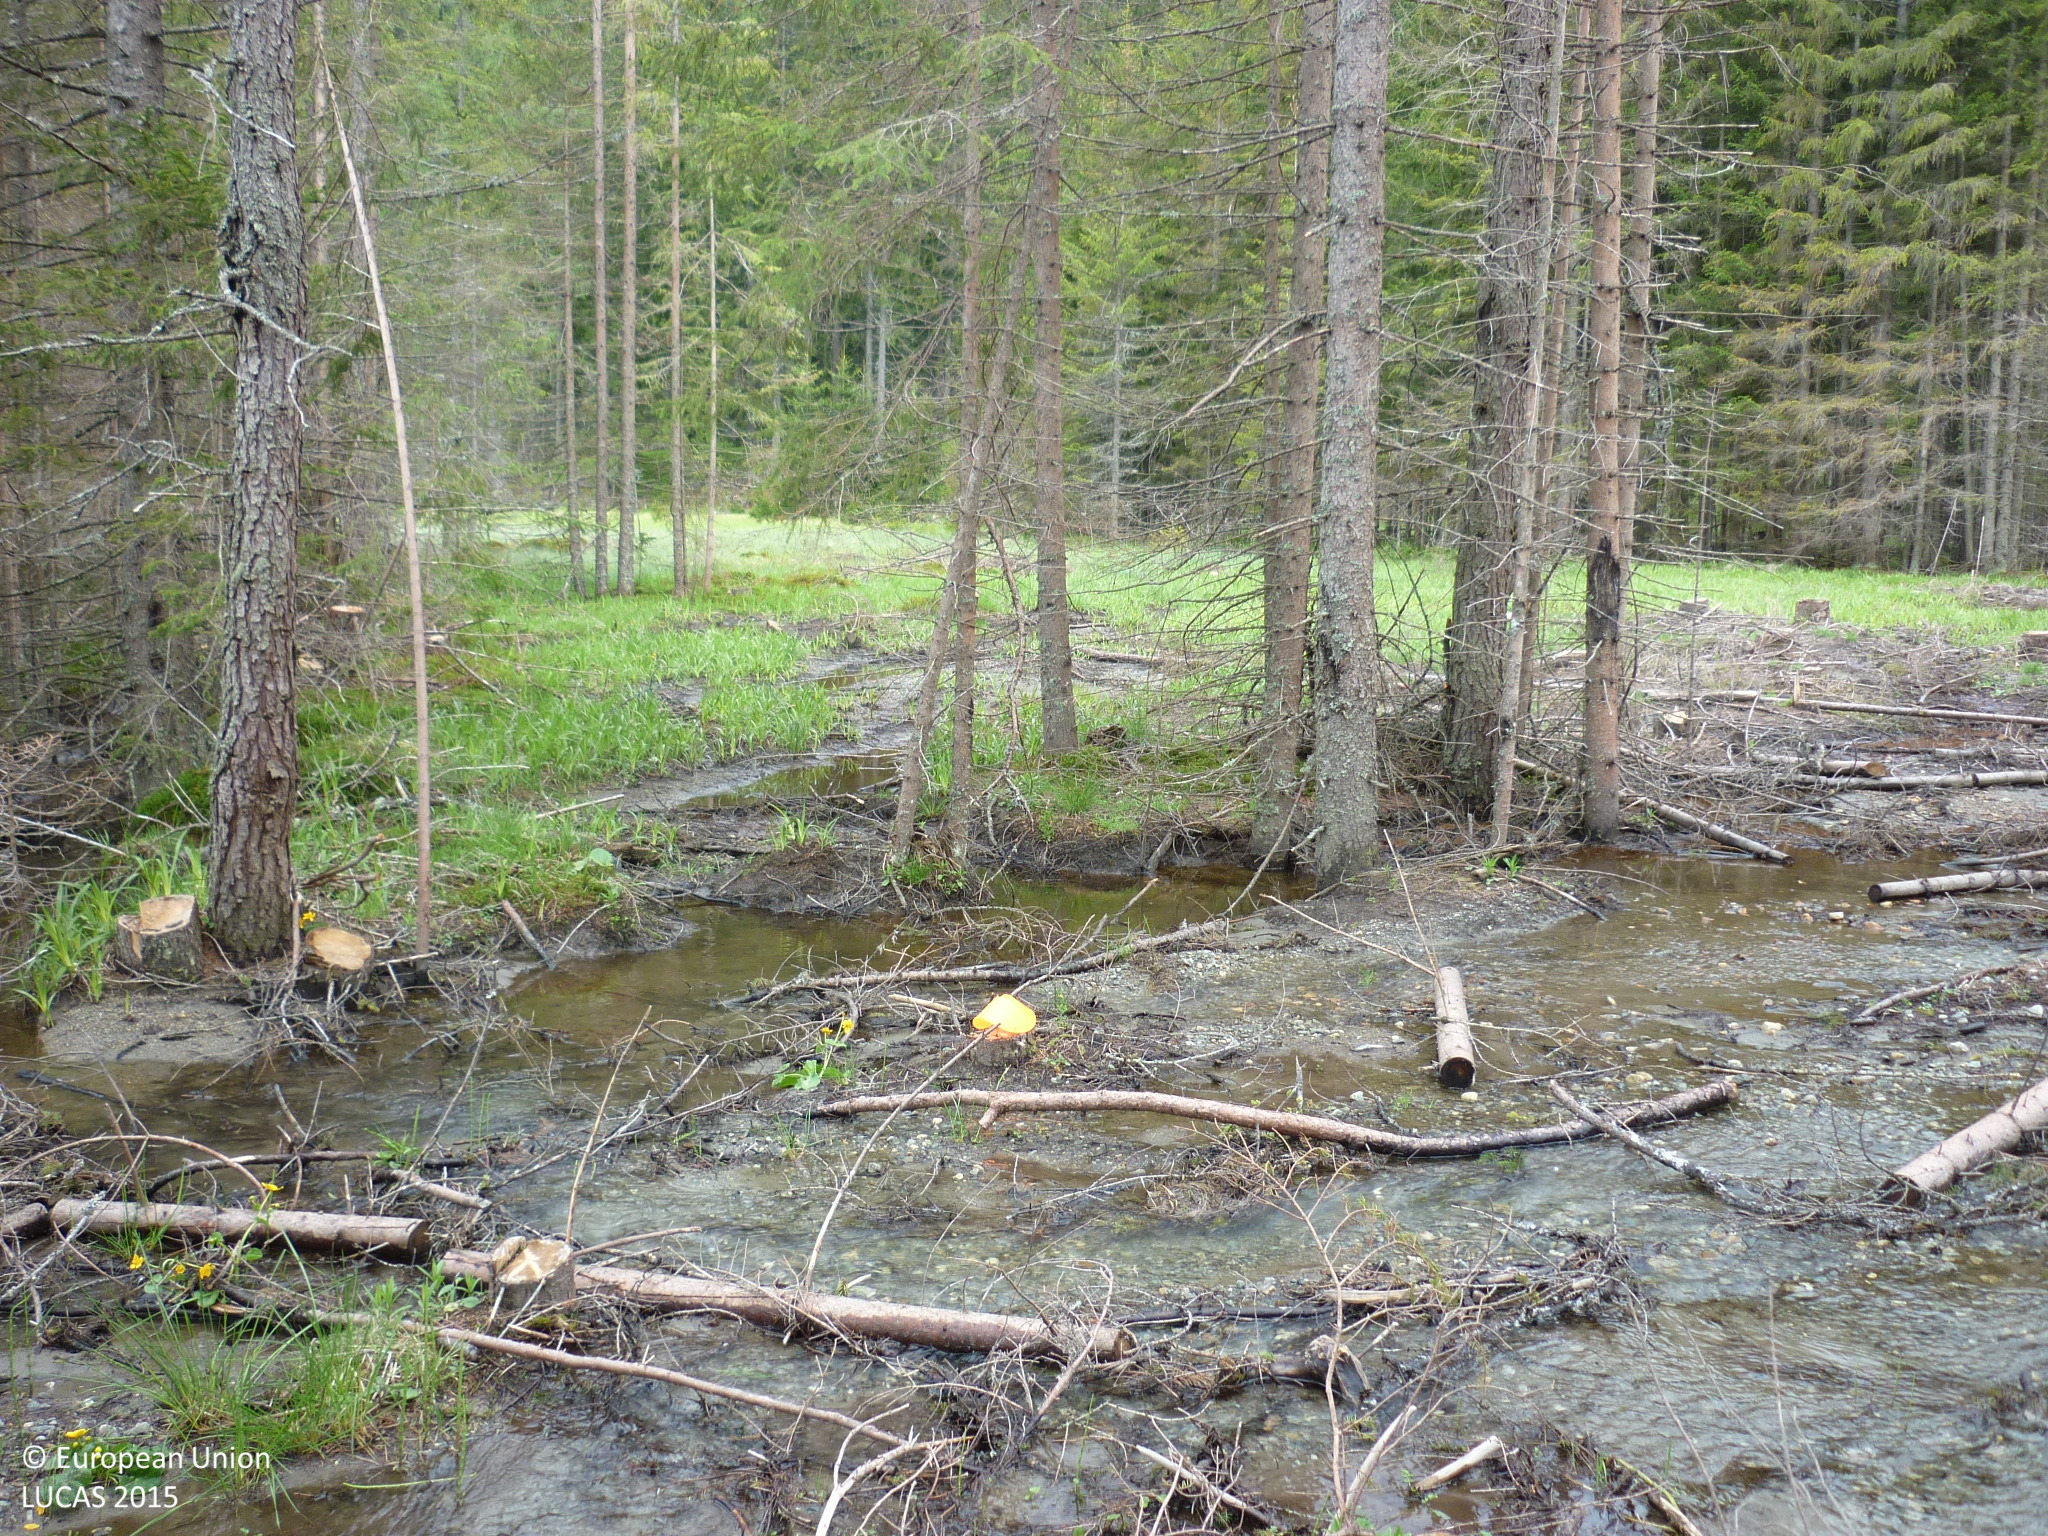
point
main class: Woodland
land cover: Spruce dominated coniferous woodland
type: alpine coniferous forest
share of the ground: 50 - 75 %
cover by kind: coniferous forest trees 60 %, consolidated bare surface 10 %, unconsolidated bare surface 10 %
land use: Forestry
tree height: > 5 m
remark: Temporary flooded
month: May
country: AT
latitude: 47.4132
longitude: 14.4389
